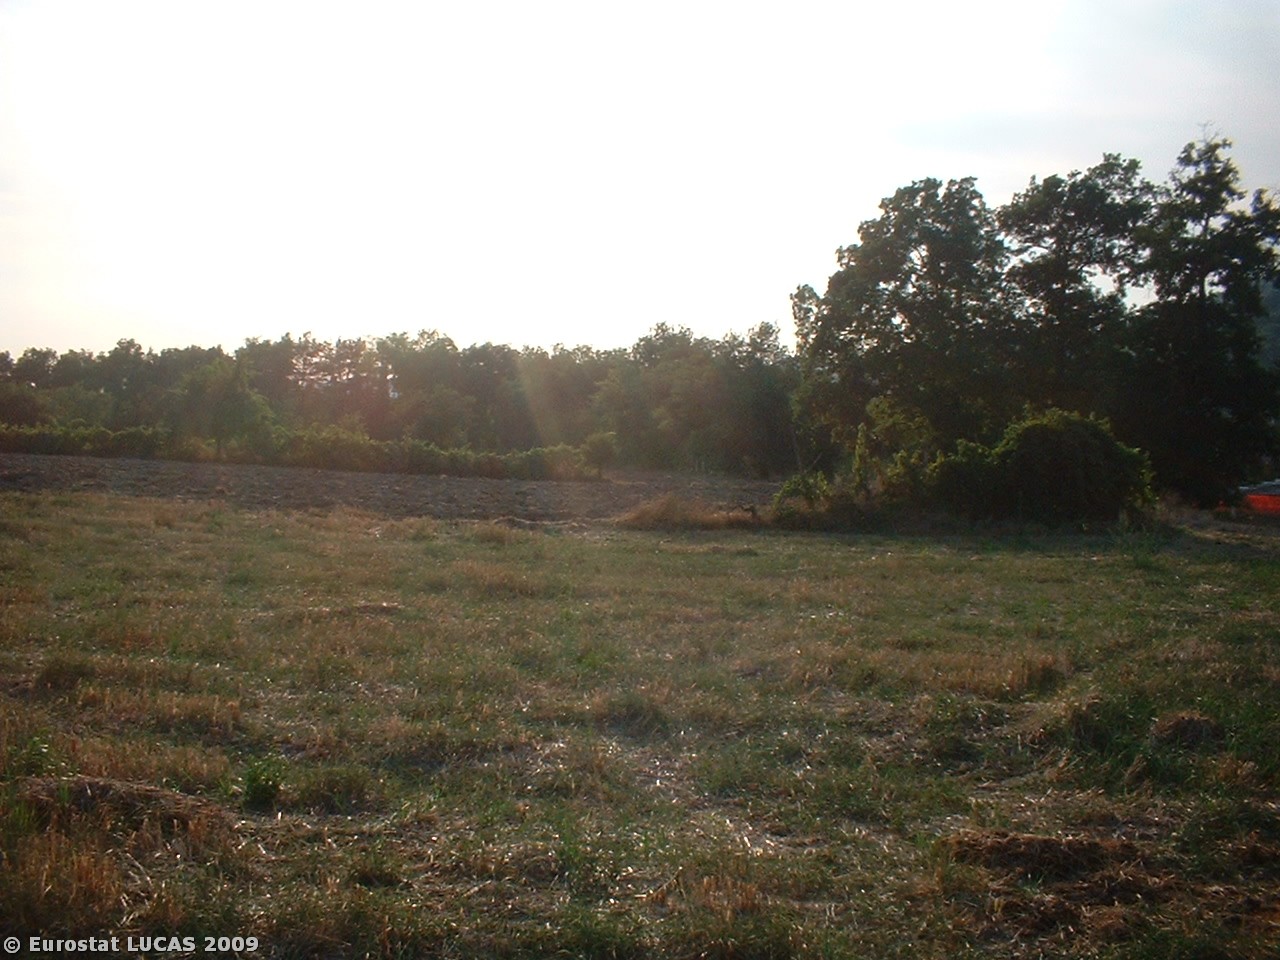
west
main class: Cropland
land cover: Durum wheat
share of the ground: < 10 %
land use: Agriculture (excluding fallow land and kitchen gardens)
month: August
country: IT
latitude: 43.5879
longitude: 12.9033
